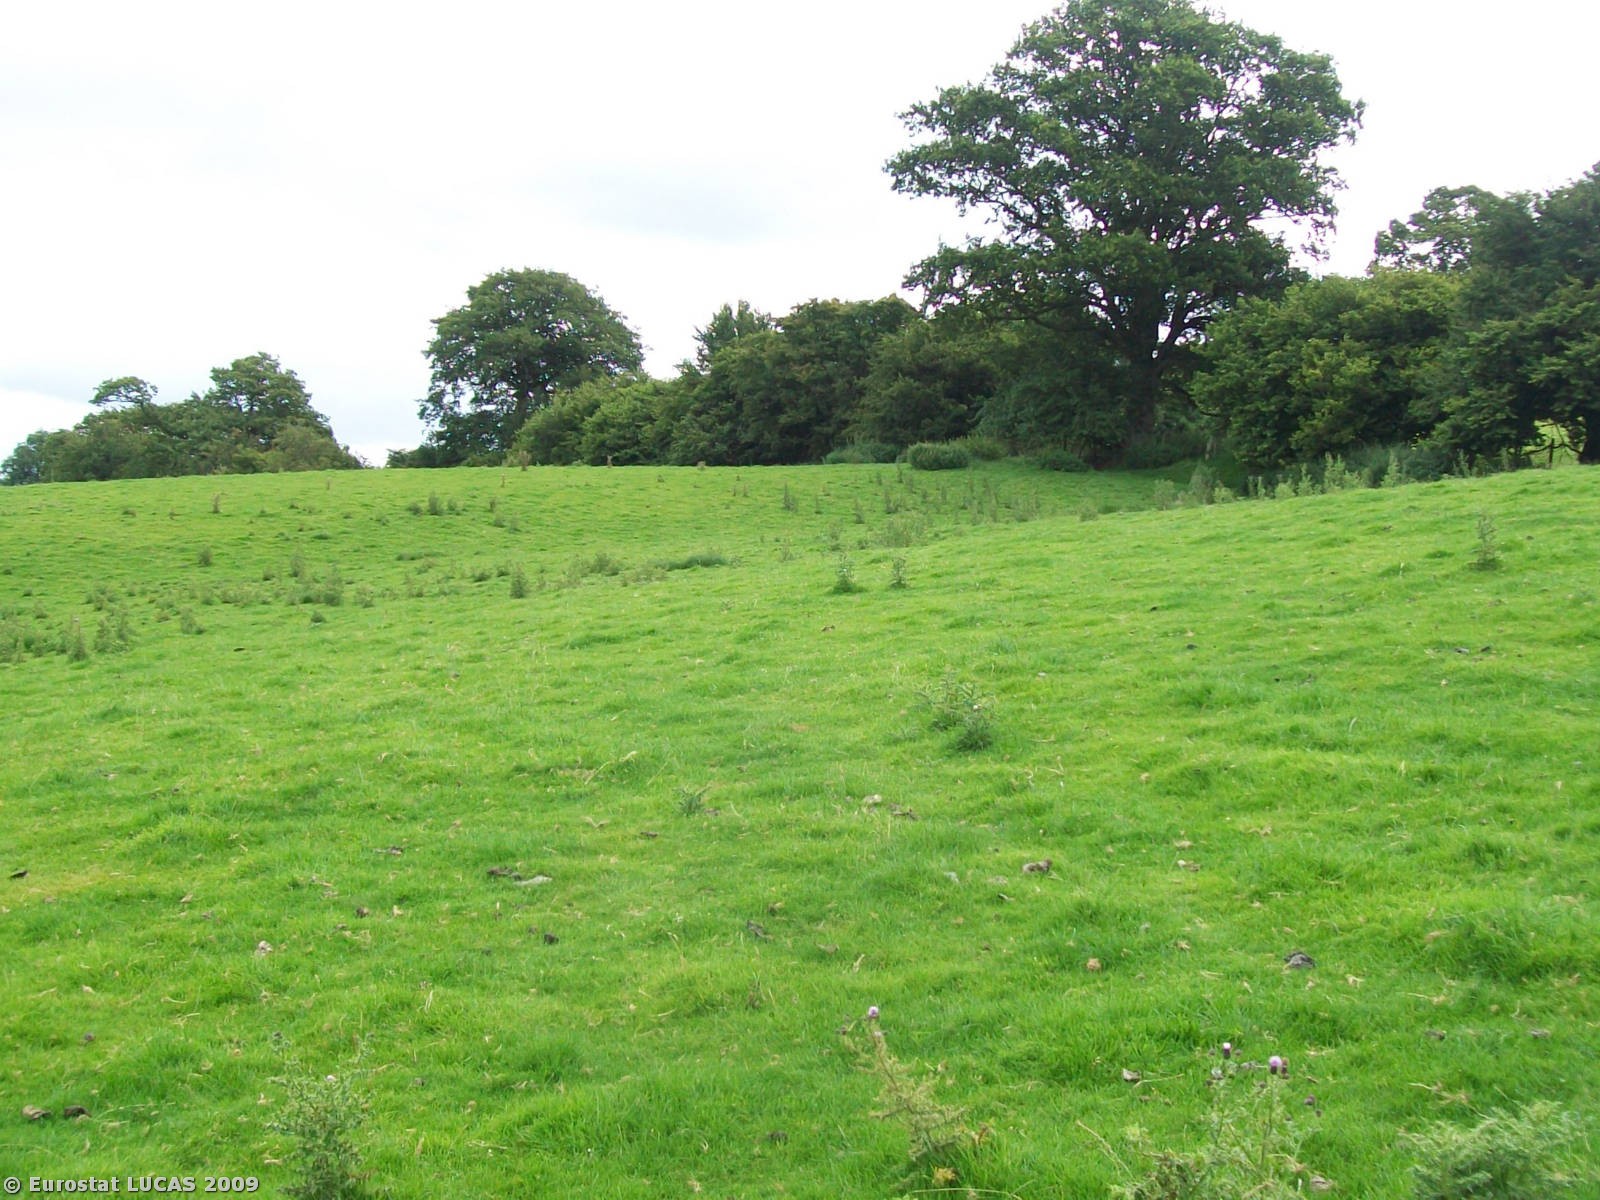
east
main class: Grassland
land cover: Grassland without tree/shrub cover
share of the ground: > 75 %
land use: Agriculture (excluding fallow land and kitchen gardens)
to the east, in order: Grassland without tree/shrub cover; Fences; Single bushes/trees; Grass margins; Grassland without tree/shrub cover; Managed hedges; Grassland without tree/shrub cover
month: August
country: GB
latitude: 52.6096
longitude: -3.2974
